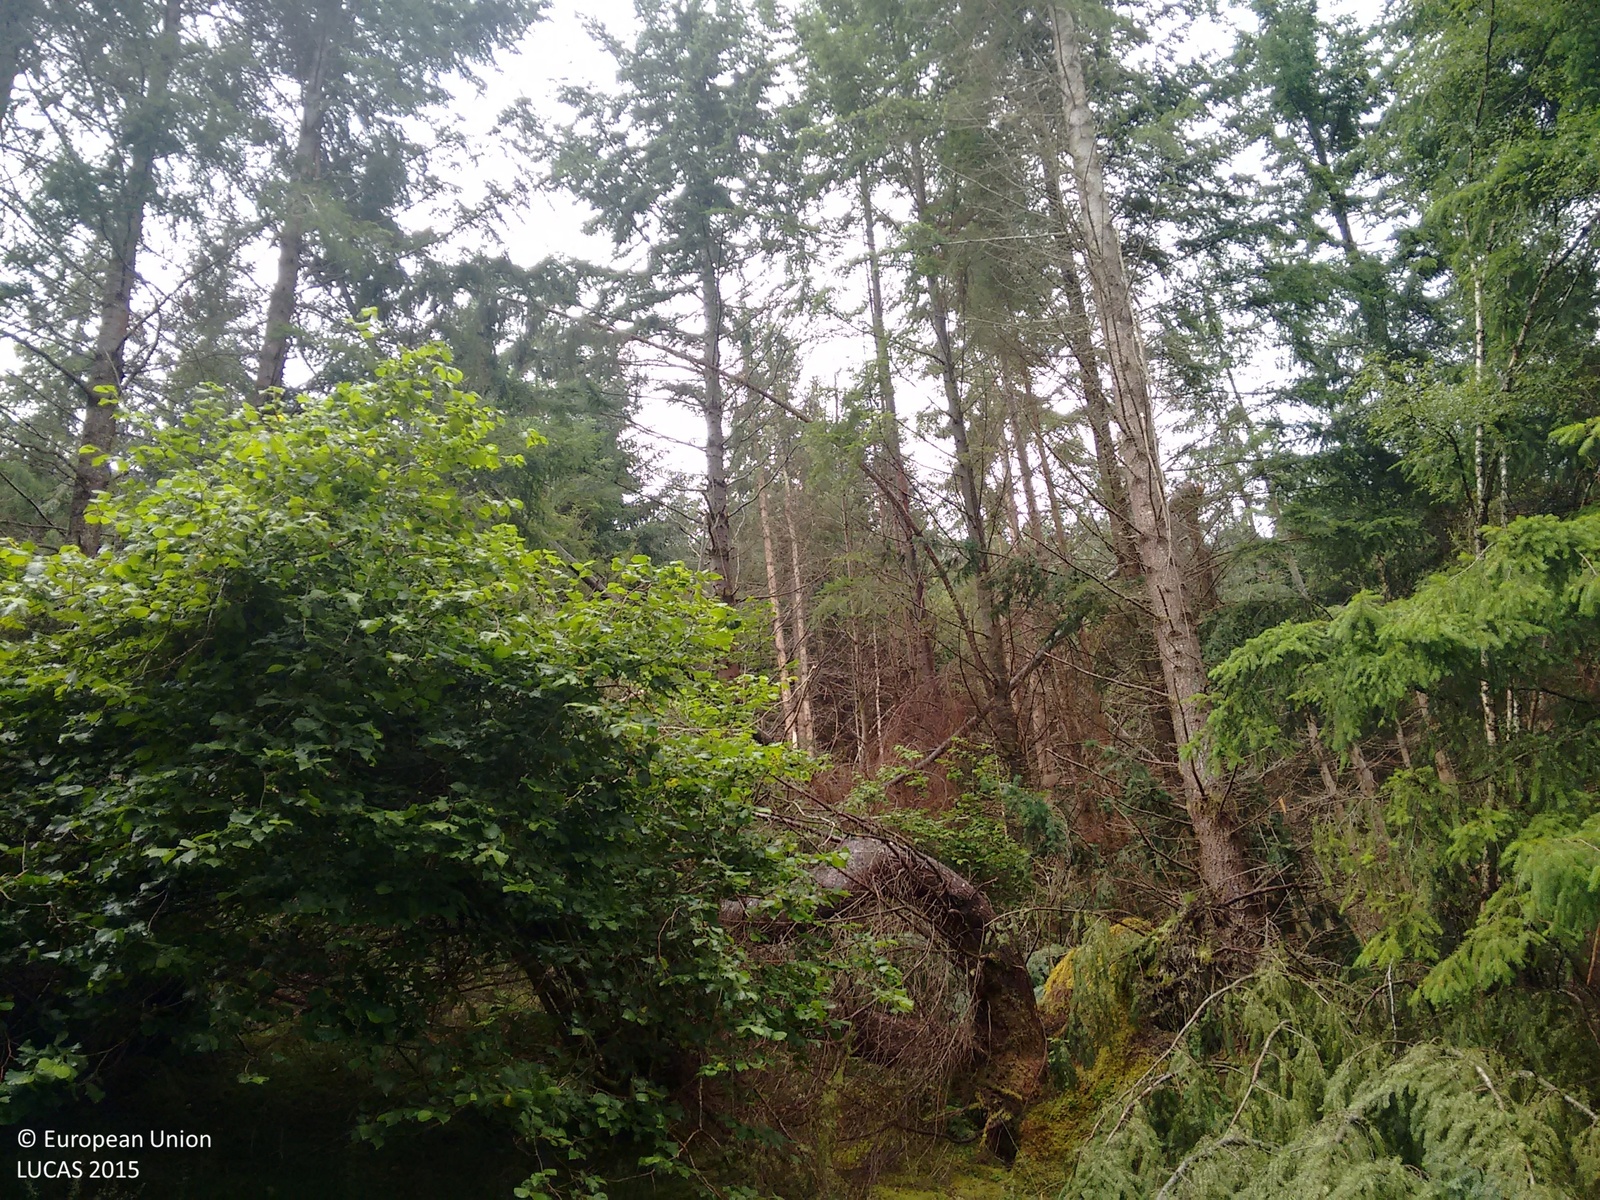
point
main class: Woodland
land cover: Spruce dominated coniferous woodland
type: exotic forest
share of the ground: > 75 %
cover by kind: coniferous forest trees 100 %
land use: Forestry
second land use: Amenities, museums, leisure
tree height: > 5 m
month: August
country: GB
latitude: 57.3288
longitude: -4.5602
